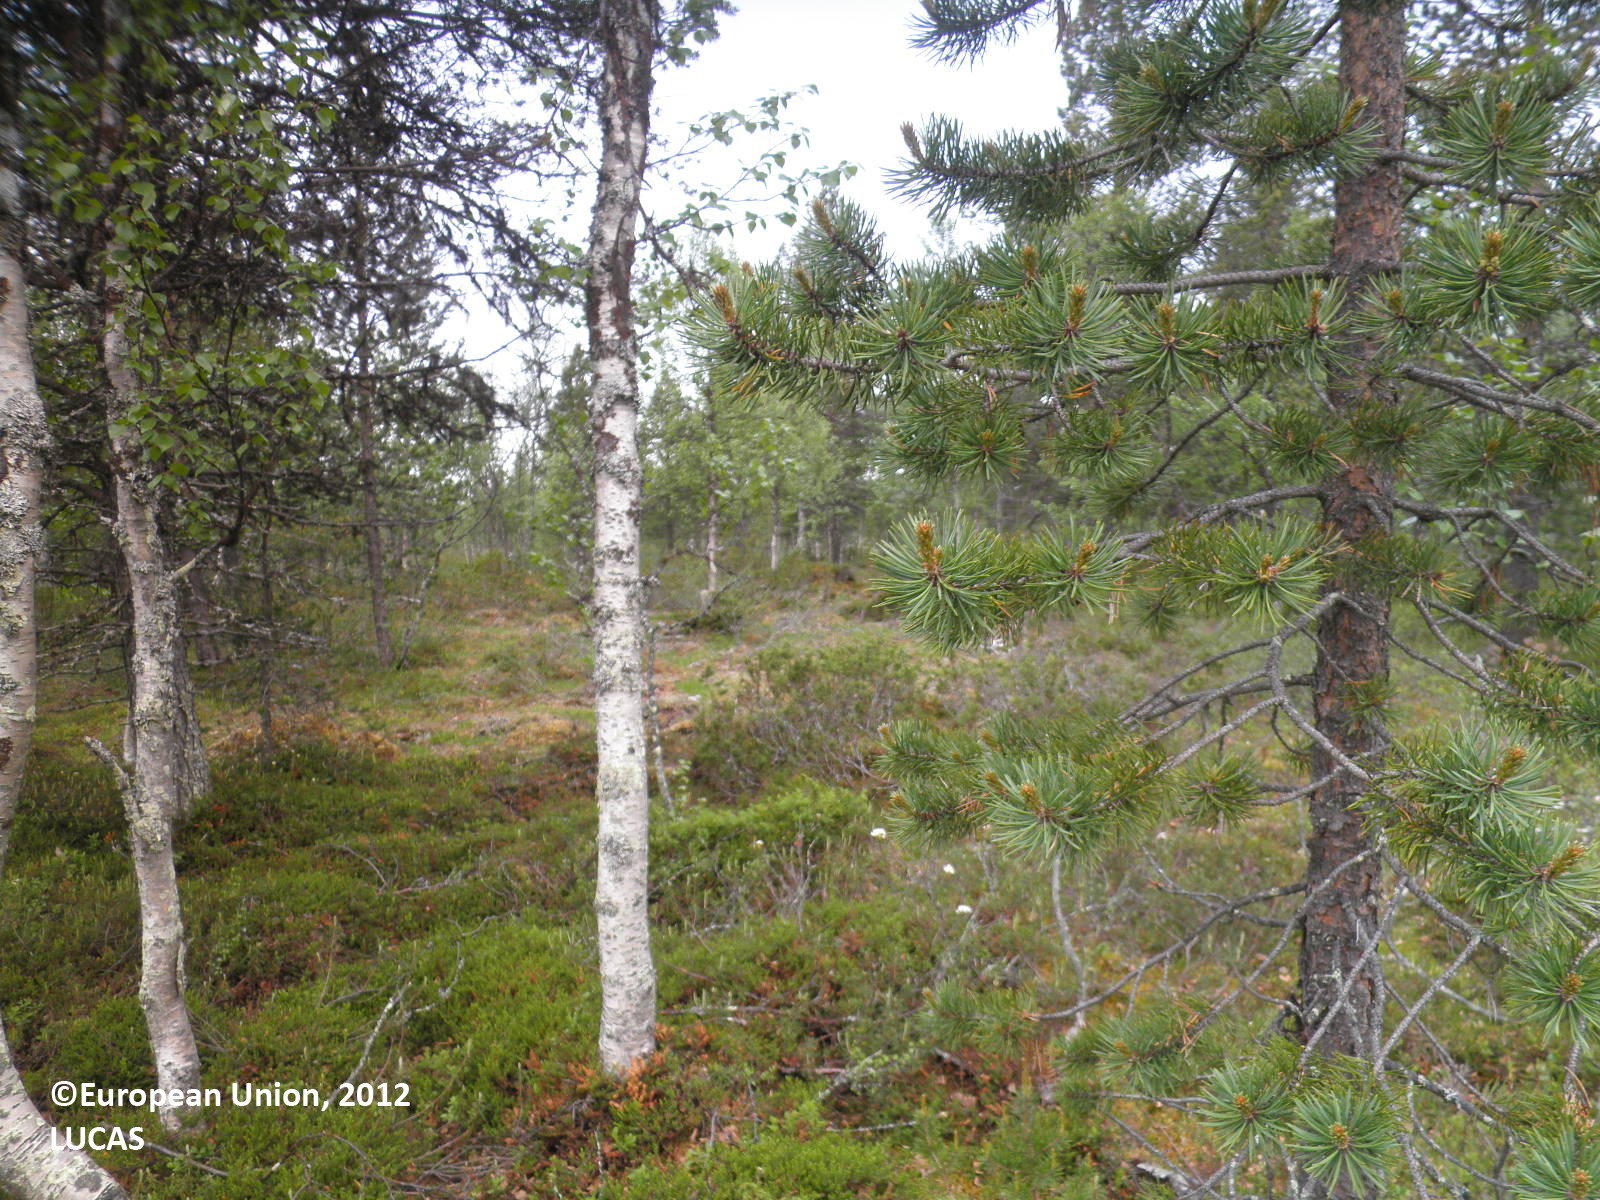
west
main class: Woodland
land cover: Pine dominated mixed woodland
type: boreal forest
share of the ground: 50 - 75 %
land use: Forestry
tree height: > 5 m
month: July
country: FI
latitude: 68.4001
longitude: 25.6406
